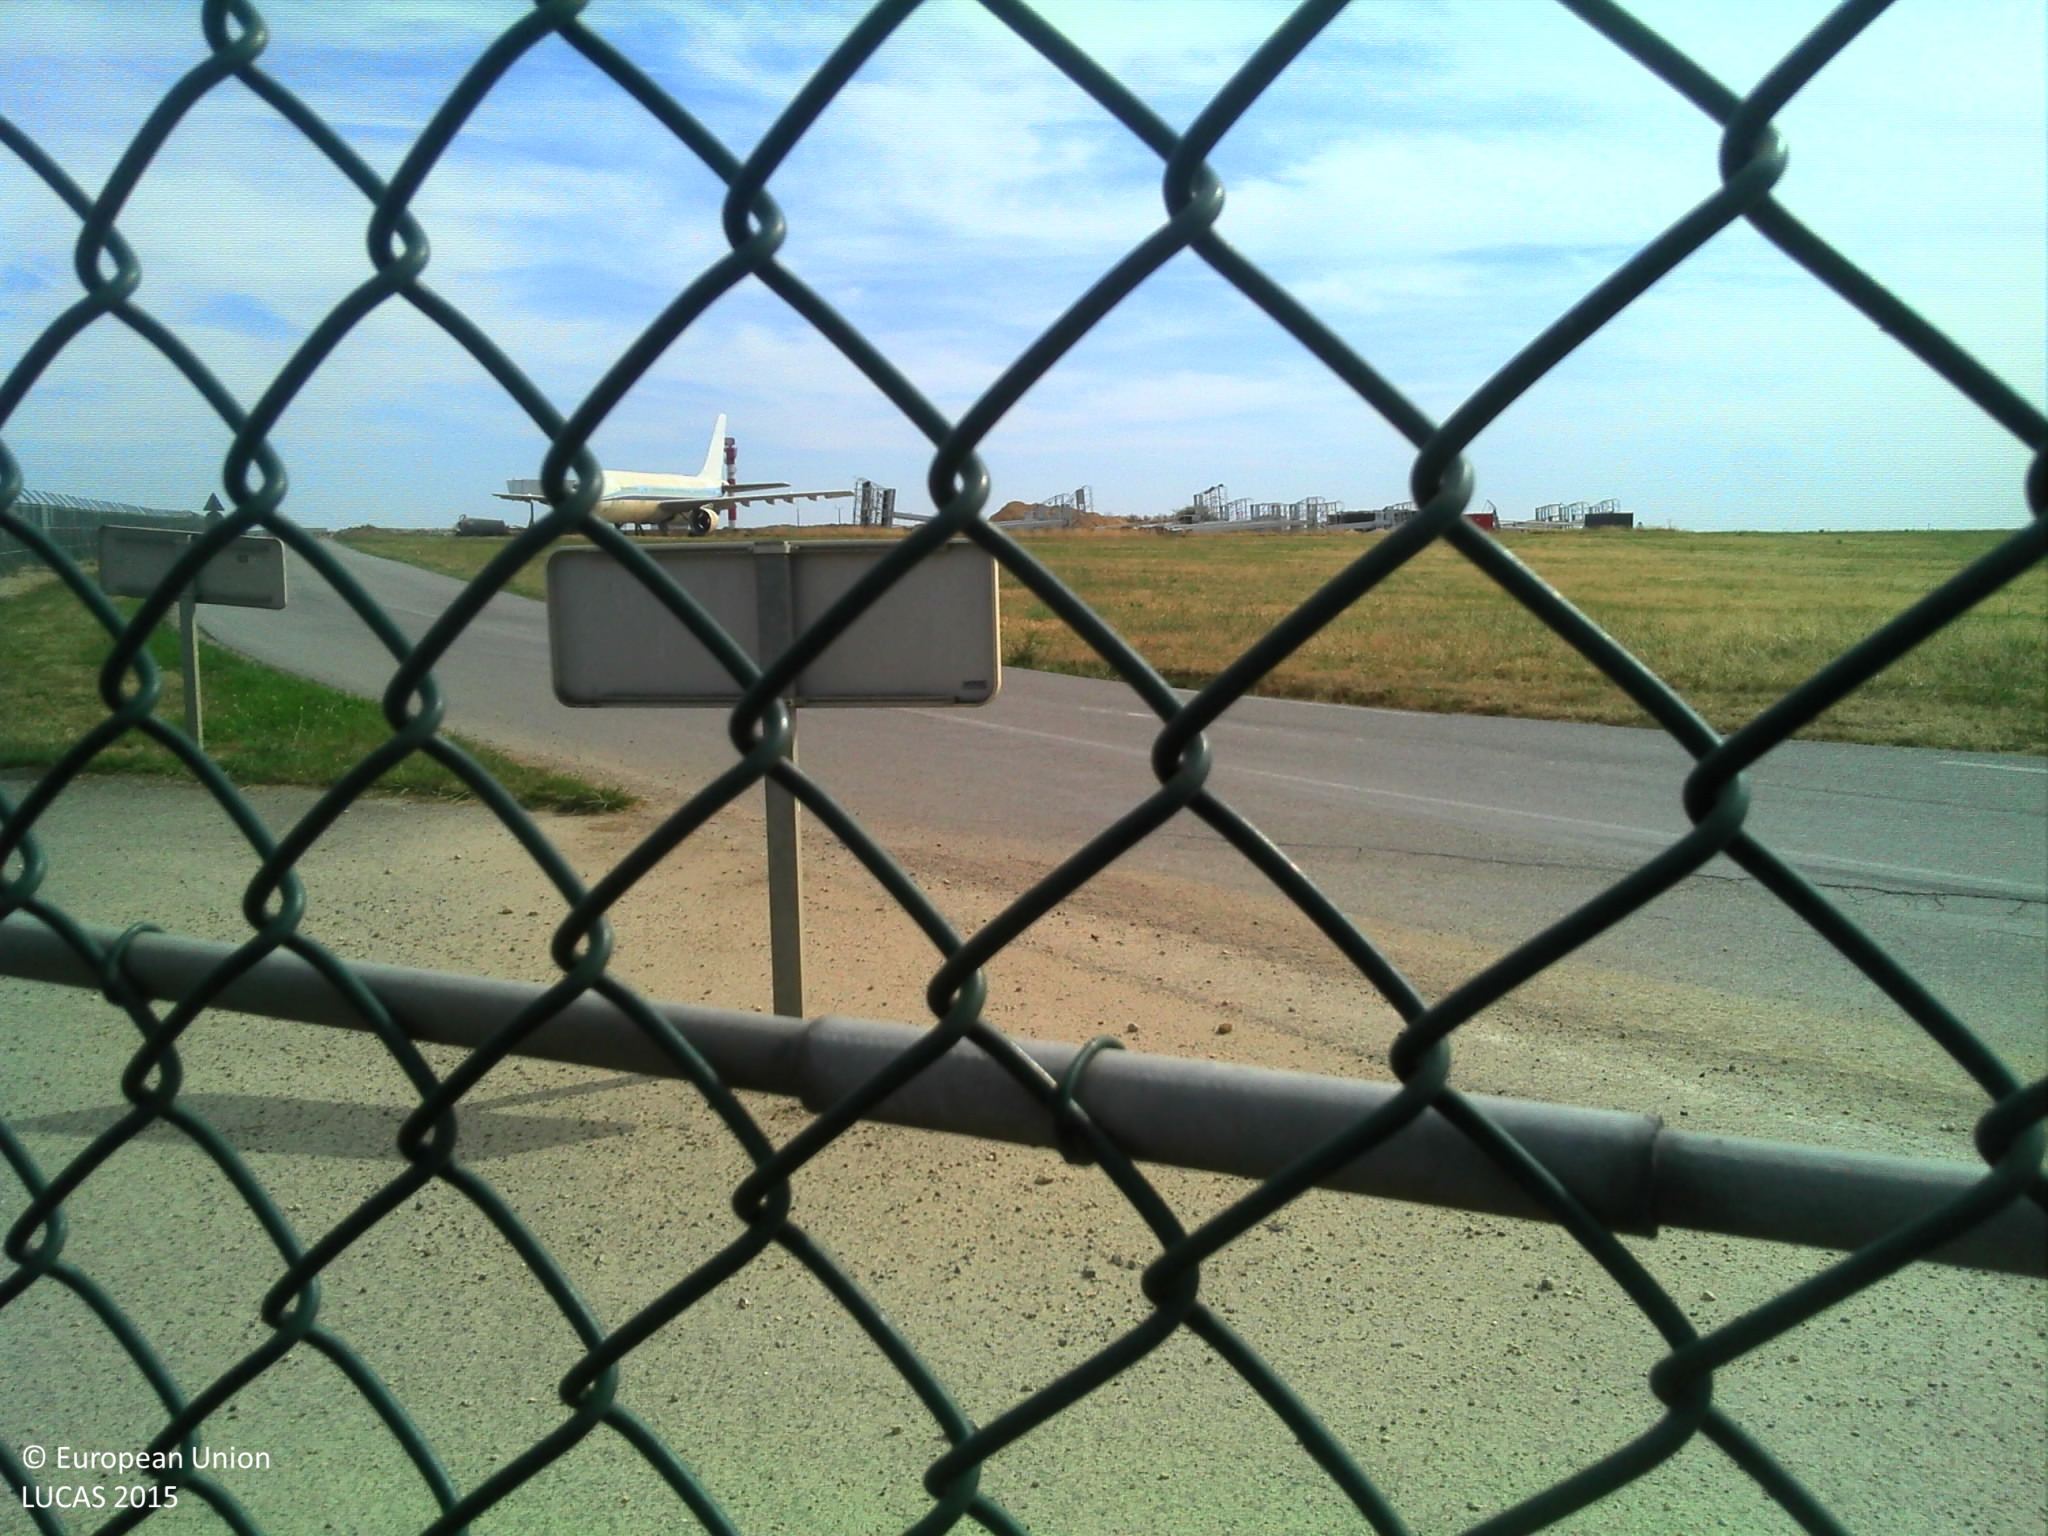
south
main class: Grassland
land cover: Grassland without tree/shrub cover
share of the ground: > 75 %
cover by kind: herbaceous plants 100 %
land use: Air transport
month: August
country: FR
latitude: 48.7372
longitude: 2.3874
